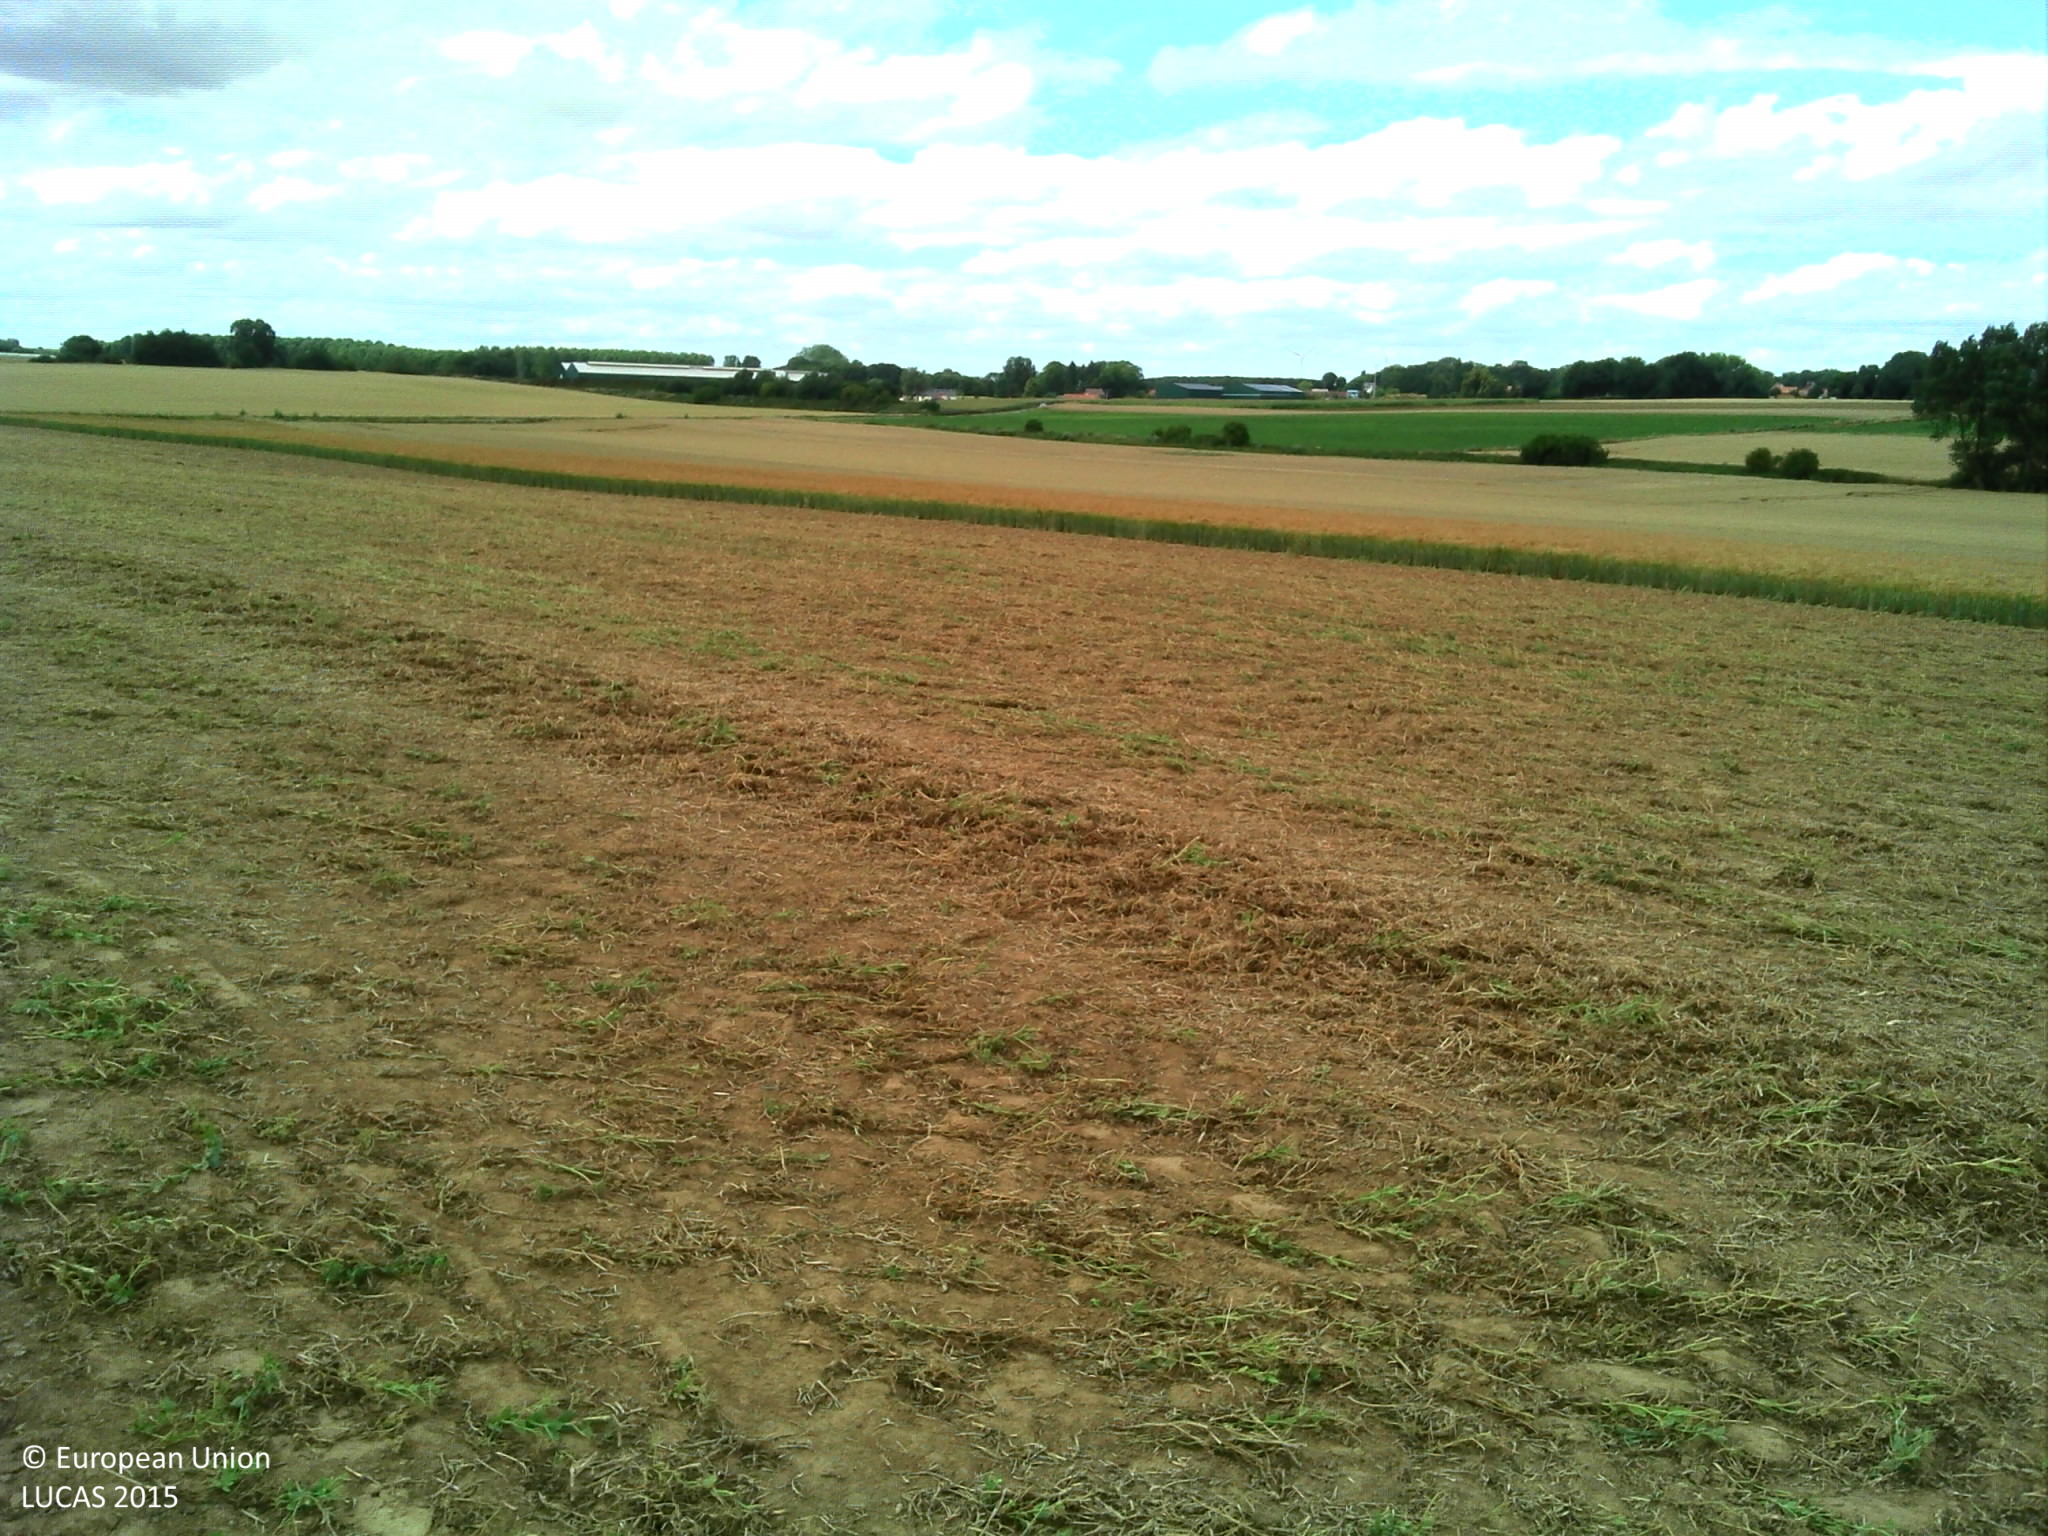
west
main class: Cropland
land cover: Other fresh vegetables
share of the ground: < 10 %
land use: Agriculture (excluding fallow land and kitchen gardens)
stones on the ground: < 10 %
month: July
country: FR
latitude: 50.1199
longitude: 2.8144
